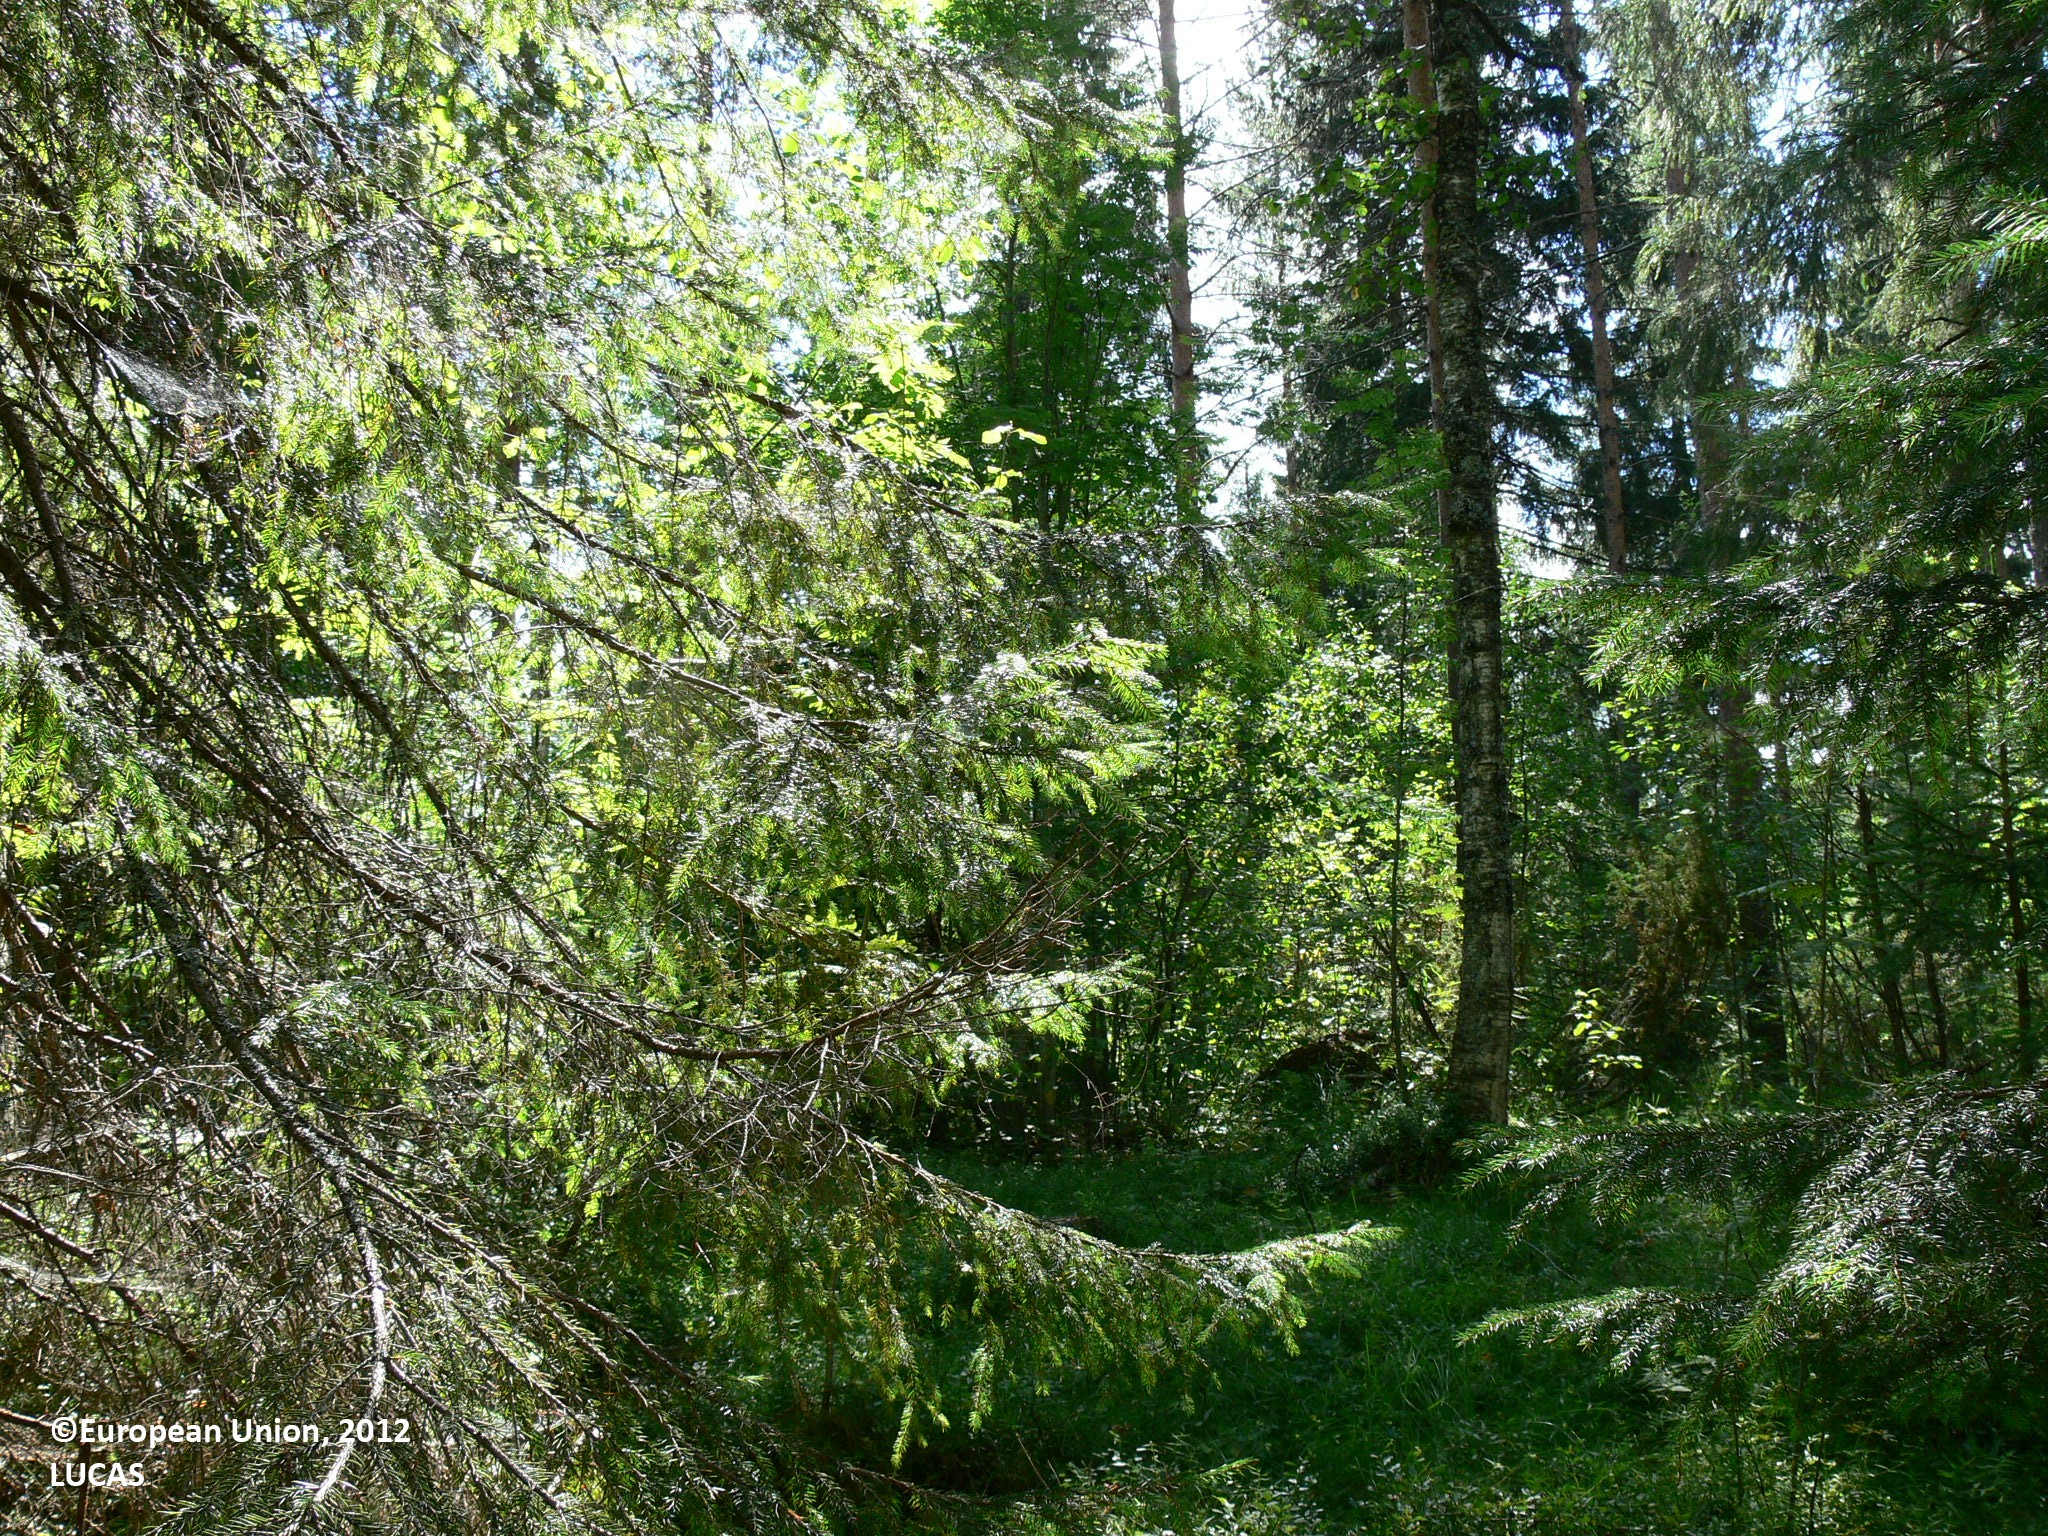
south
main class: Woodland
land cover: Other mixed woodland
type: boreal forest
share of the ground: > 75 %
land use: Forestry
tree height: > 5 m
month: August
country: FI
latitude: 62.1325
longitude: 30.3590
